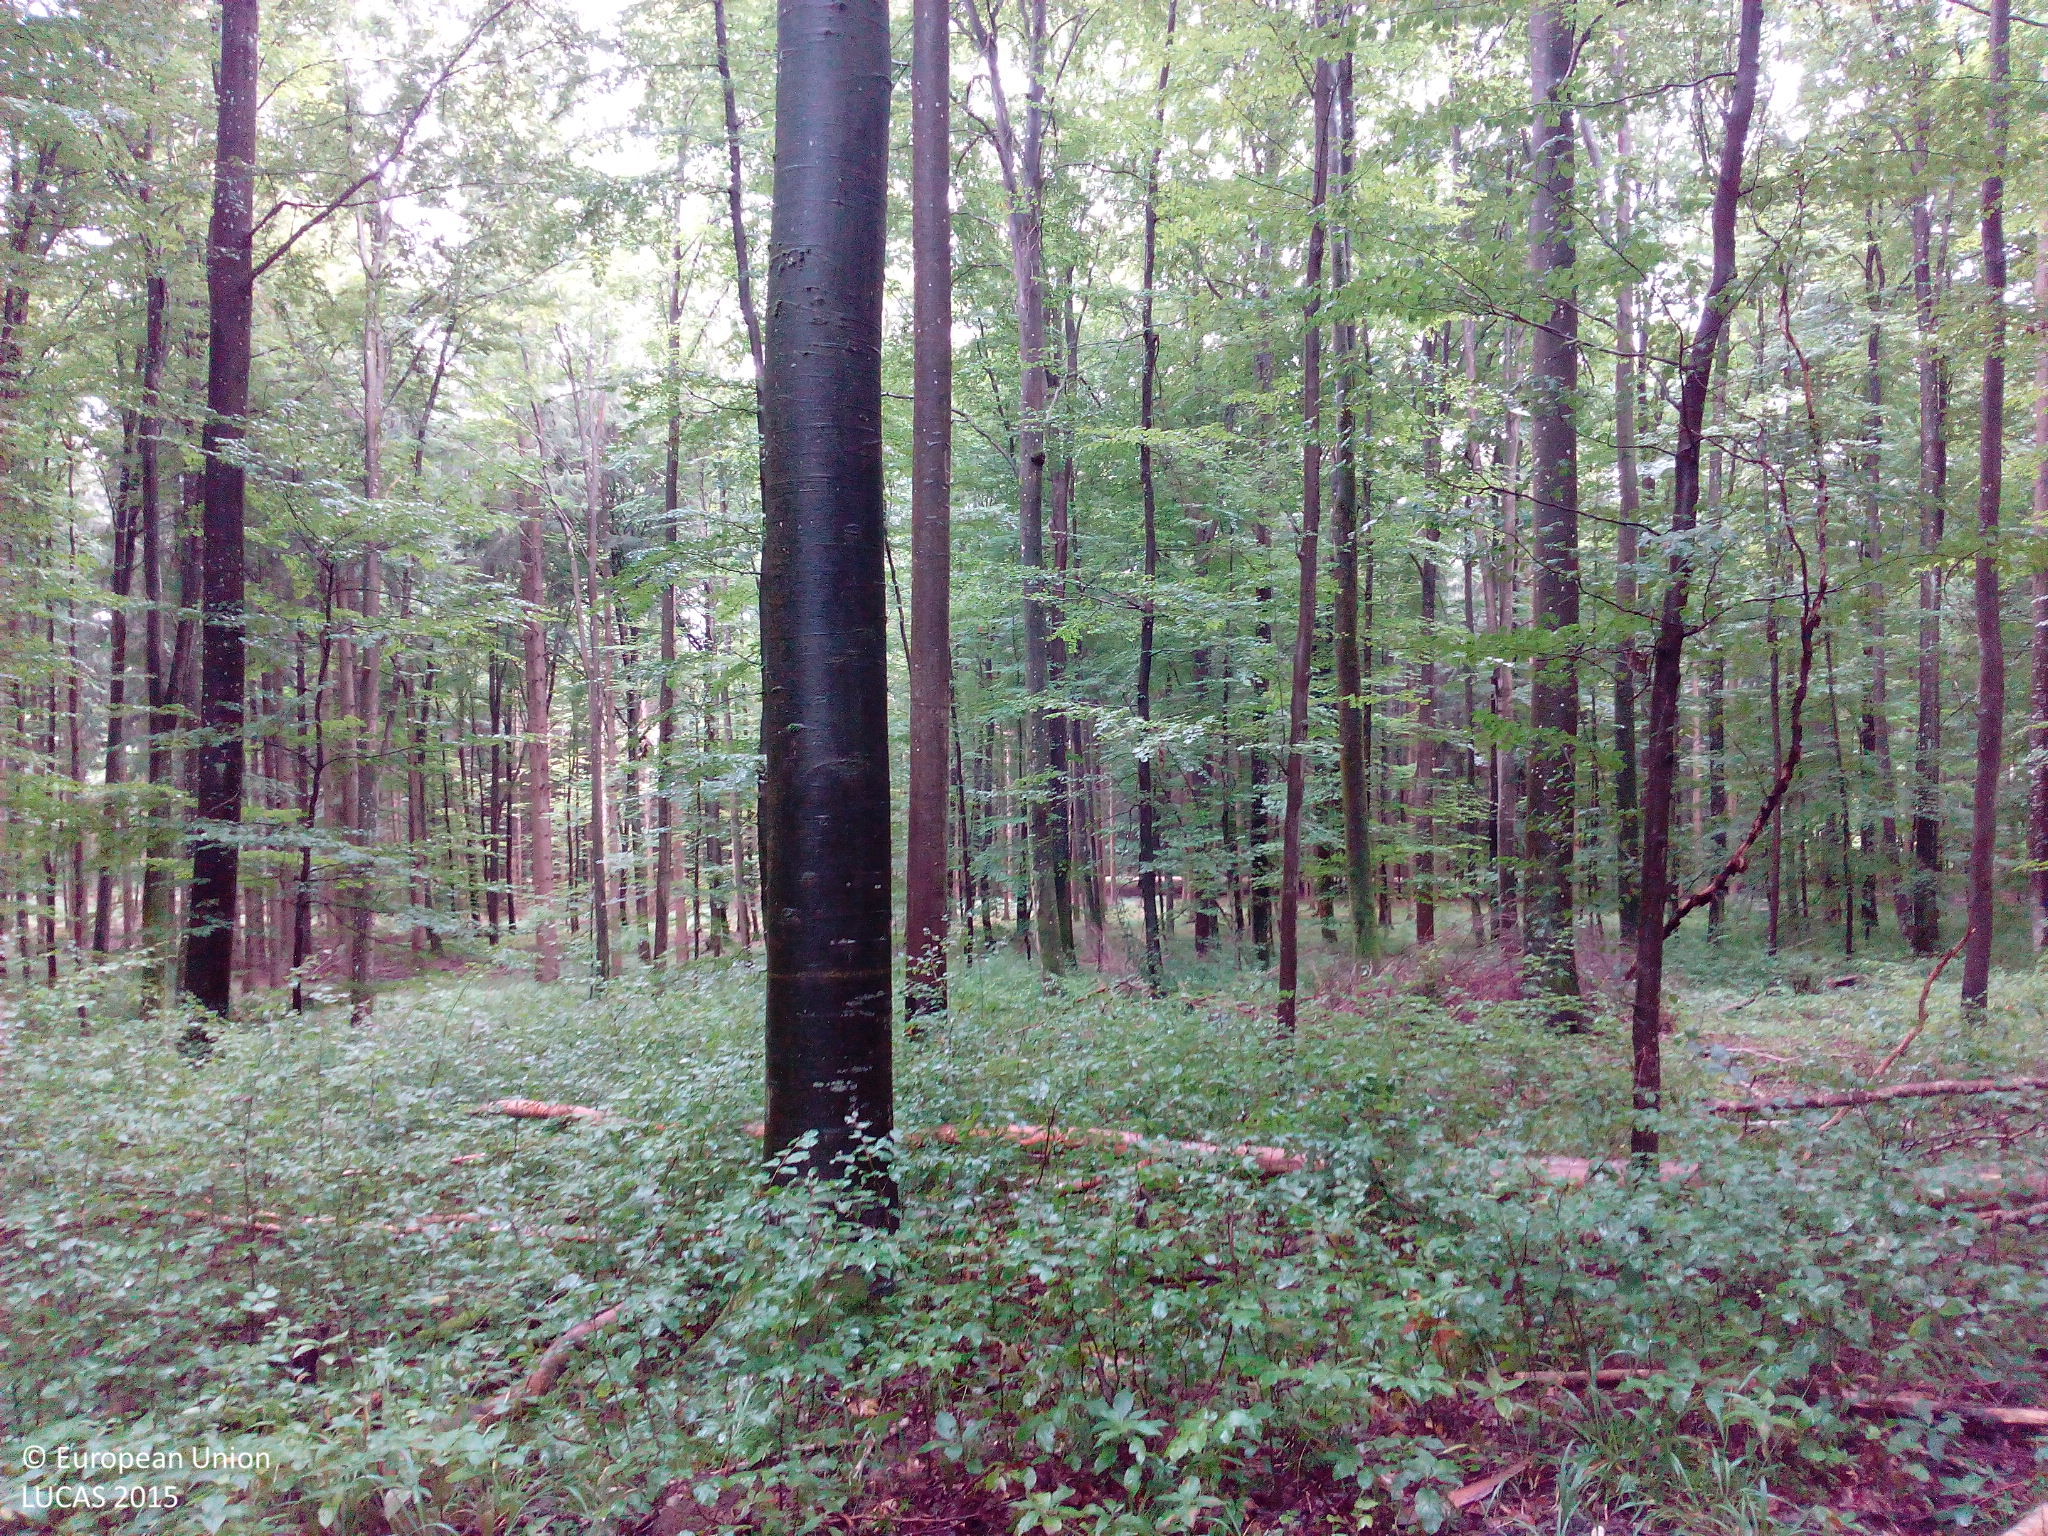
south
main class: Woodland
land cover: Broadleaved woodland
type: mesophytic deciduous forest
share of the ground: > 75 %
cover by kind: broadleaved forest trees 70 %, coniferous forest trees 15 %, shrubs 10 %, unconsolidated bare surface 5 %
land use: Forestry
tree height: > 5 m
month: August
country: DE
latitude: 48.5474
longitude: 9.9594
